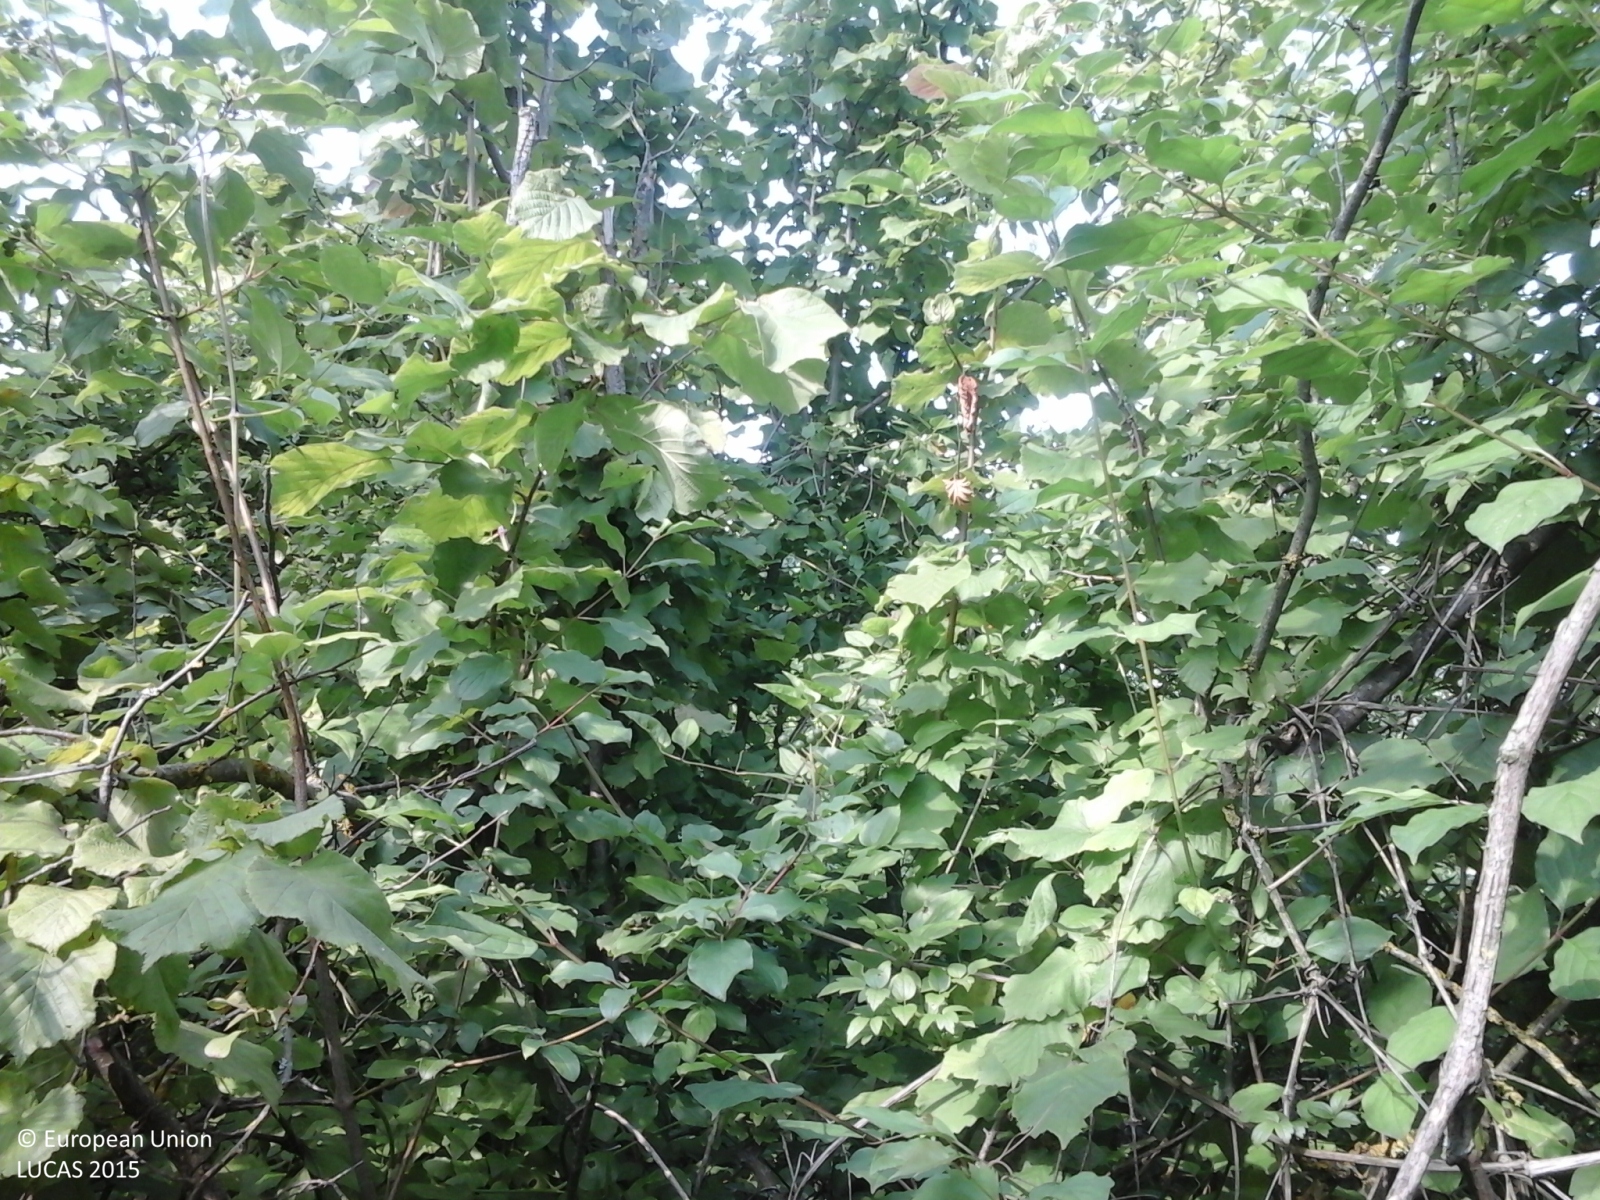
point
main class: Cropland
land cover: Nuts trees
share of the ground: > 75 %
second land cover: Spontaneously vegetated surfaces
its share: > 75 %
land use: Agriculture (excluding fallow land and kitchen gardens)
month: June
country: IT
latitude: 44.9849
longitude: 8.2404
